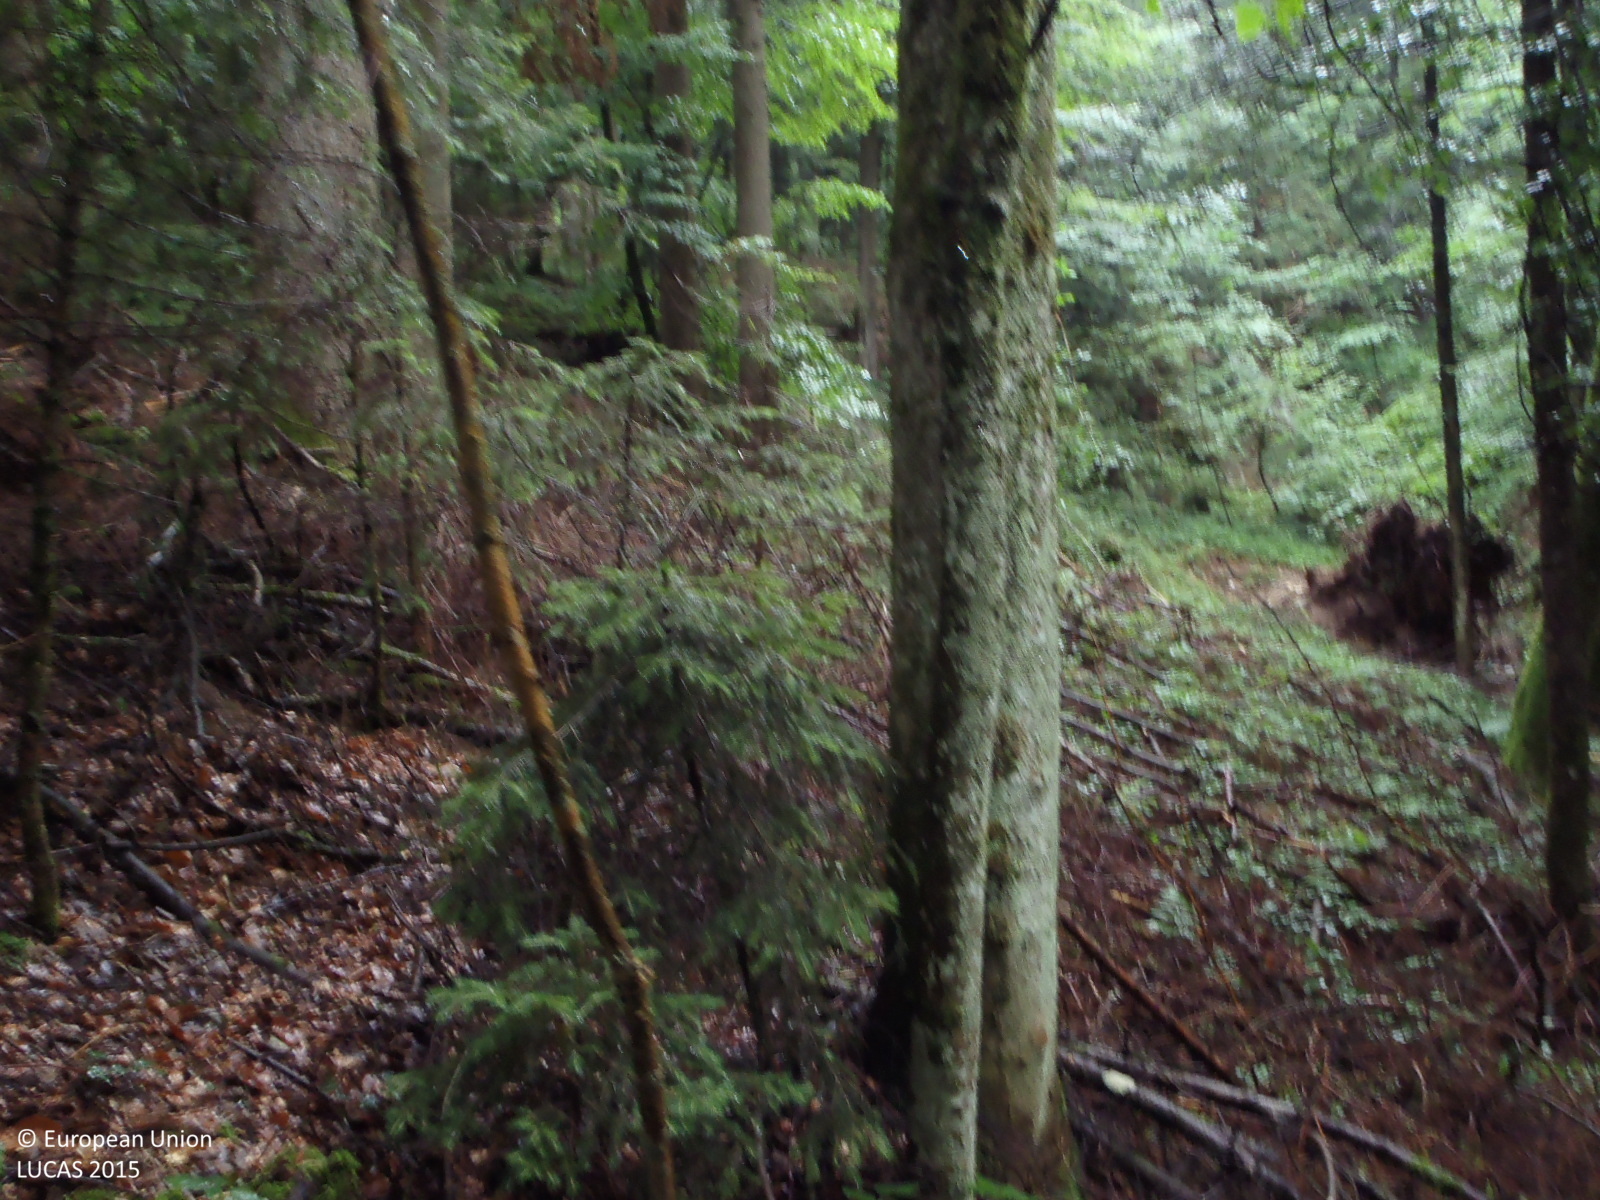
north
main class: Woodland
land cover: Broadleaved woodland
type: mountainous beech forest
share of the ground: > 75 %
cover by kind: broadleaved forest trees 80 %, coniferous forest trees 20 %
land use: Forestry
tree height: > 5 m
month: July
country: AT
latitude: 47.6610
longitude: 12.2223
